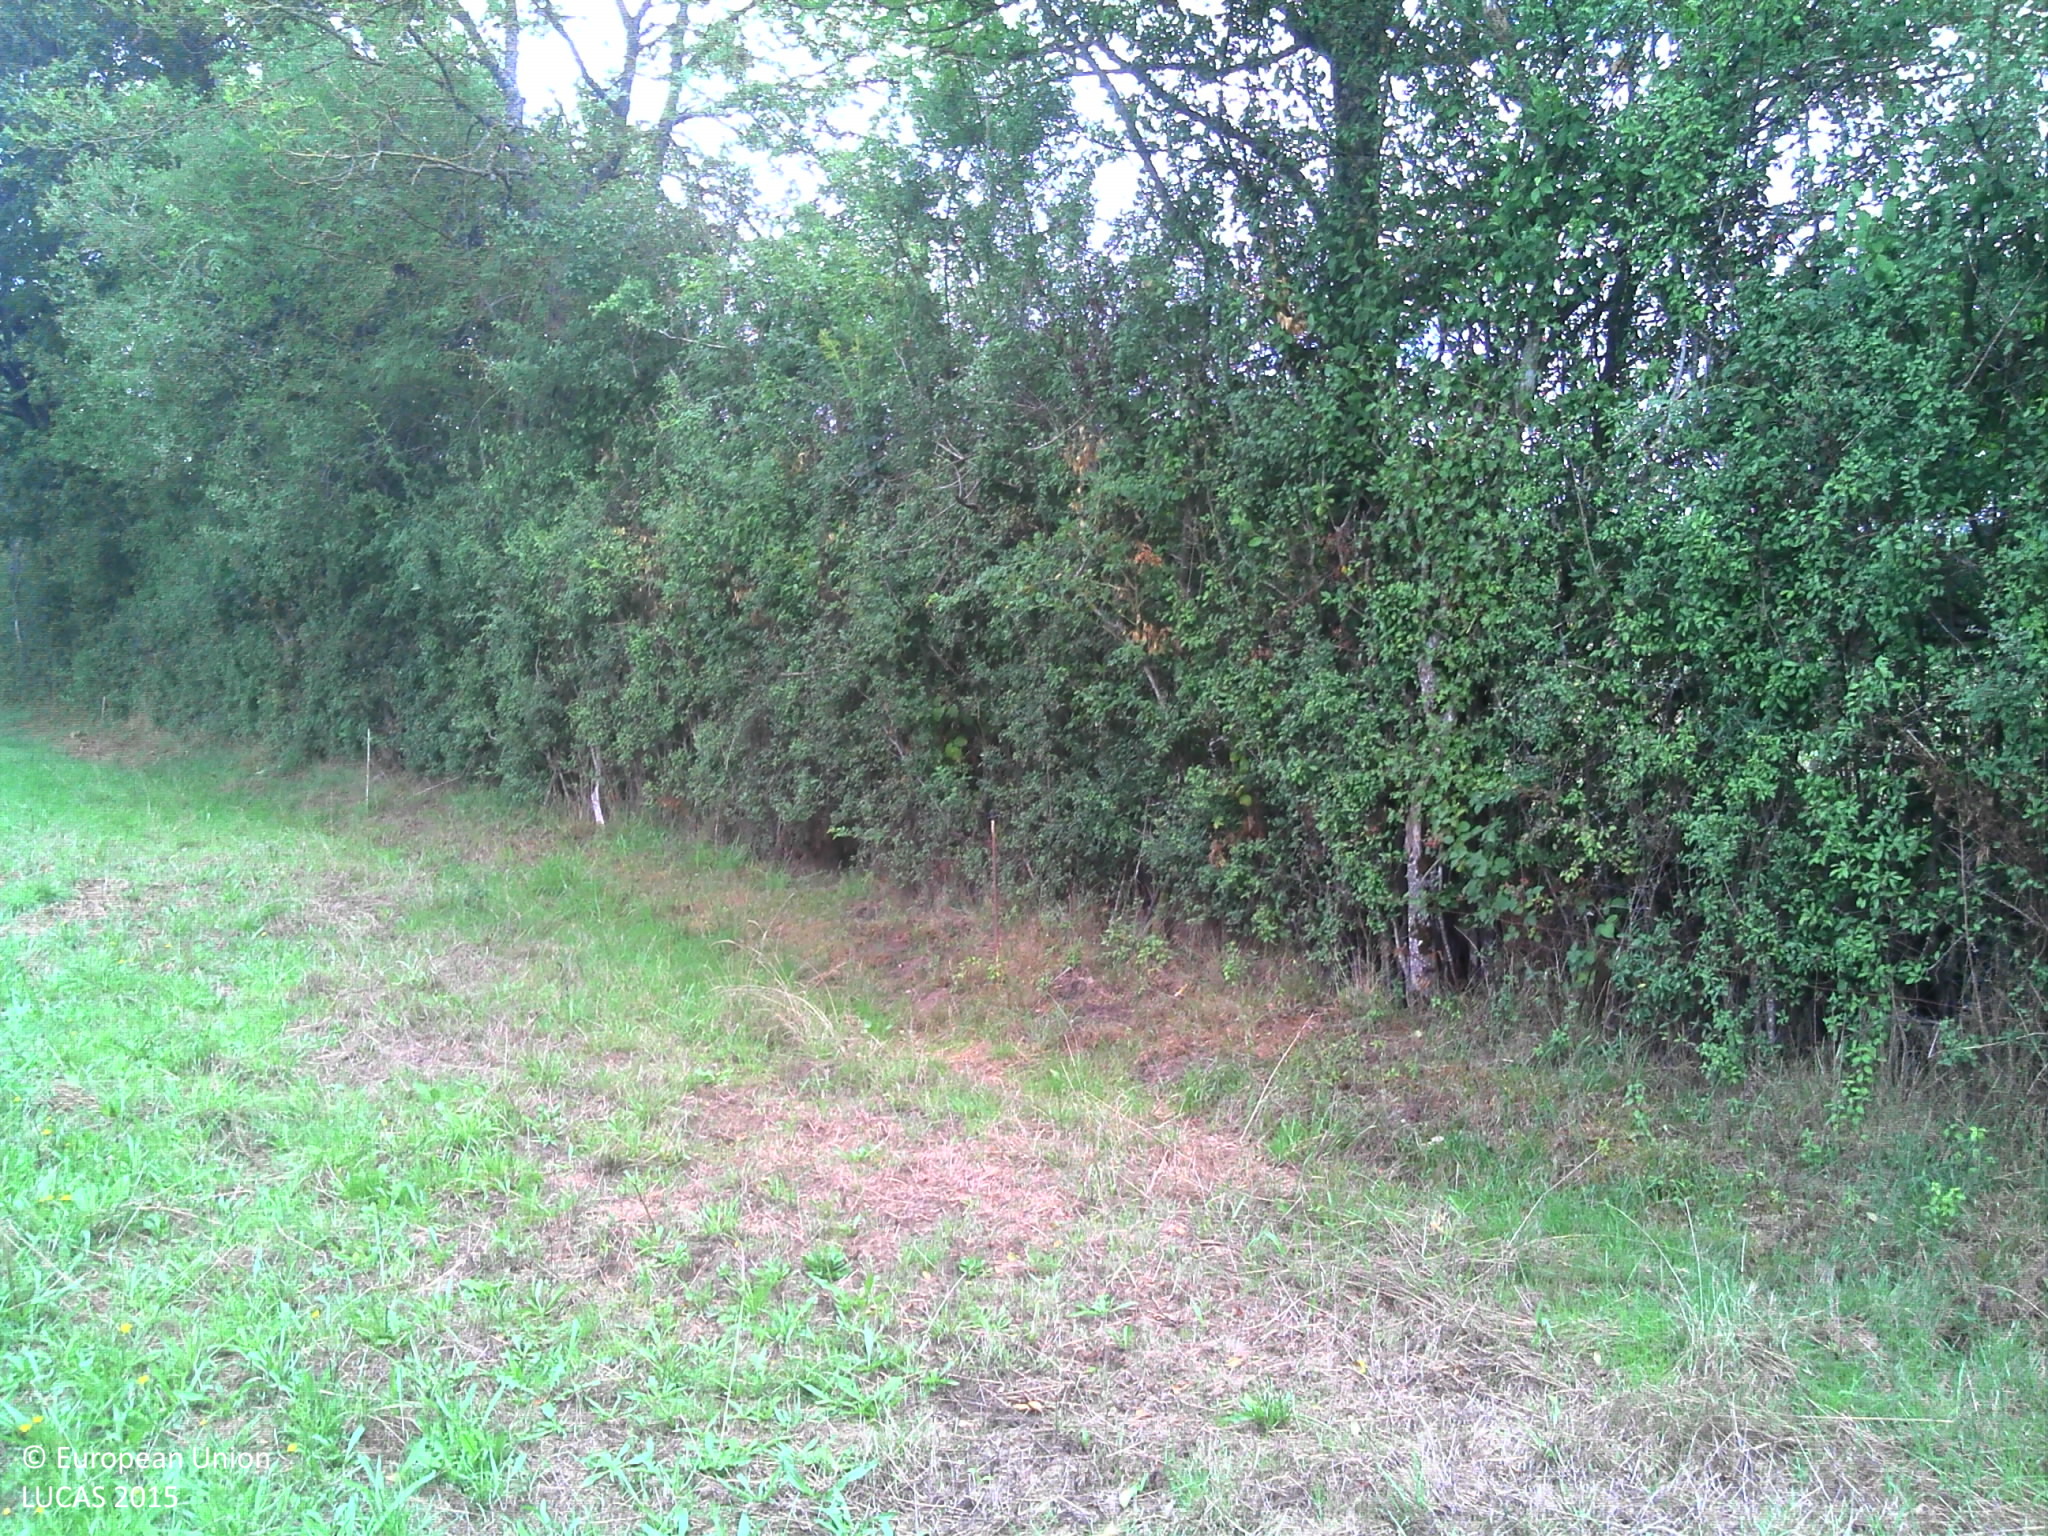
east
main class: Grassland
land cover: Grassland without tree/shrub cover
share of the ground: > 75 %
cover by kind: herbaceous plants 100 %
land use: Agriculture (excluding fallow land and kitchen gardens)
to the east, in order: Grassland without tree/shrub cover; Fences; Managed hedges; Fences; Grassland without tree/shrub cover; Broadleaved woodland; Fences; Grassland without tree/shrub cover; Fences; Broadleaved woodland
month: August
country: FR
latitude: 46.1575
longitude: 2.2124
